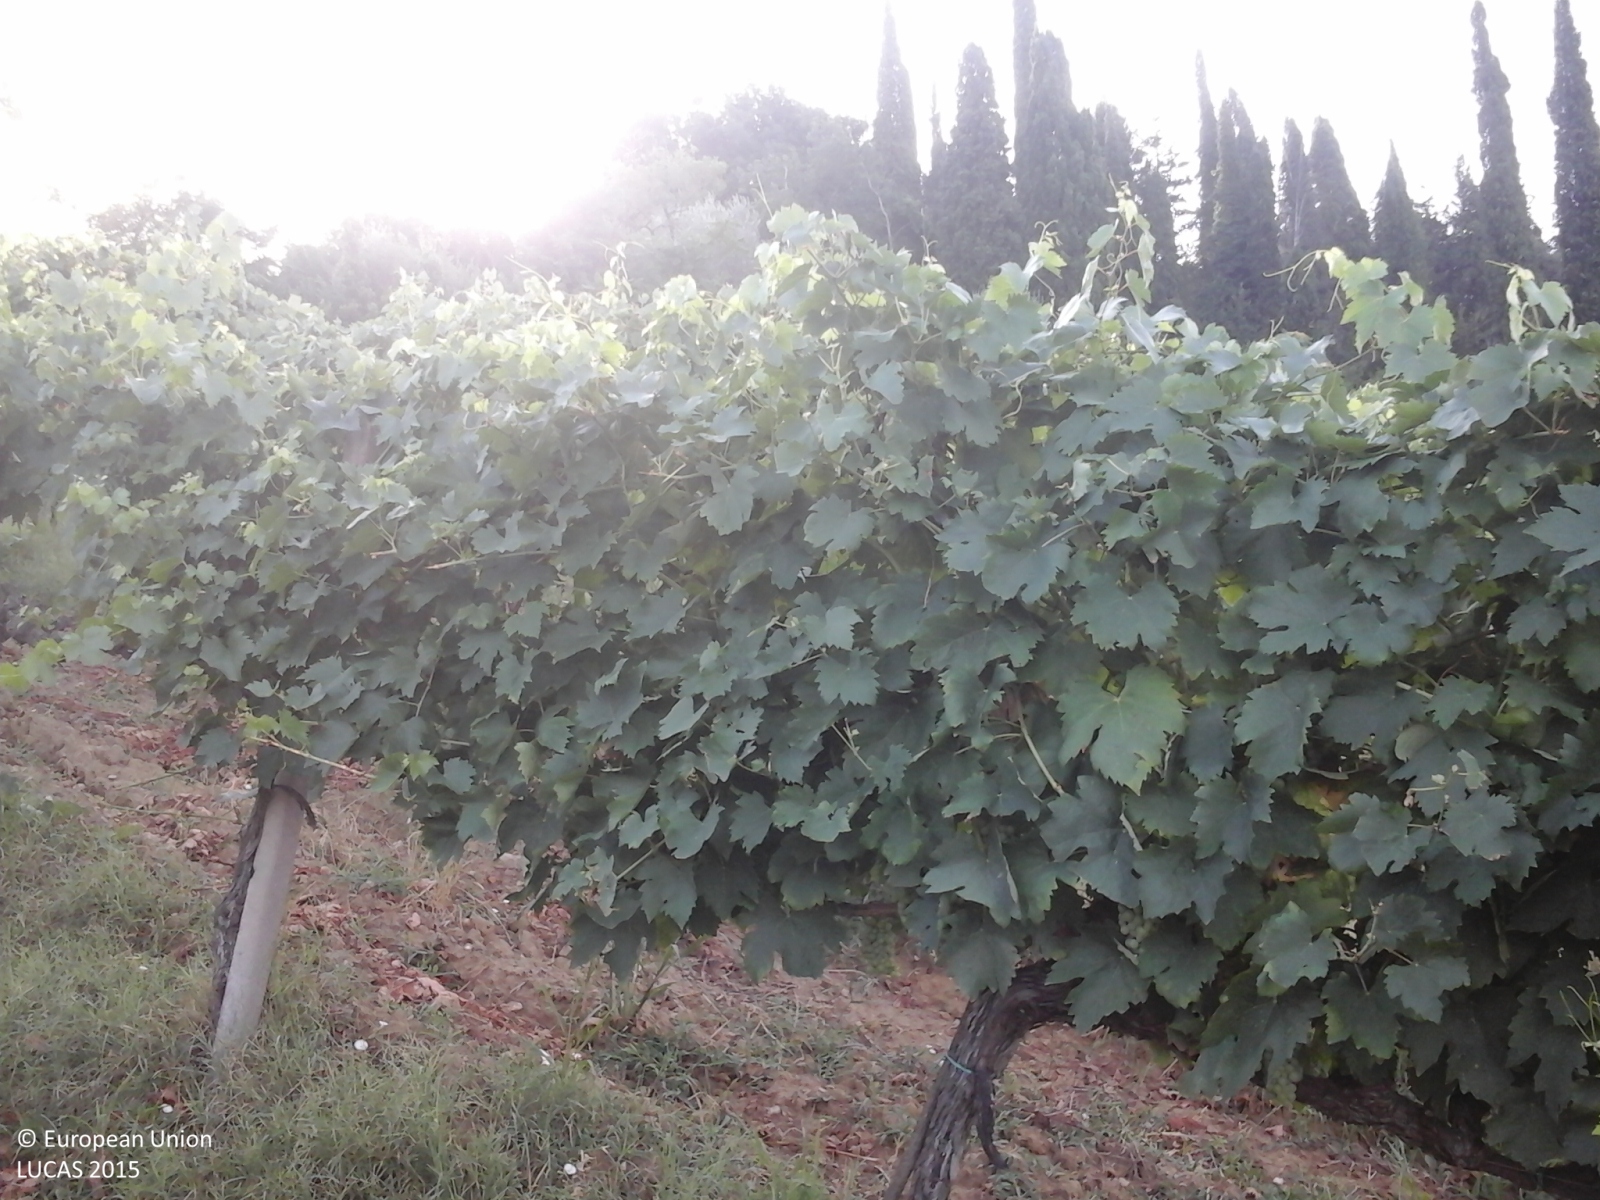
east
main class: Cropland
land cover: Vineyards
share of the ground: > 75 %
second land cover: Grassland without tree/shrub cover
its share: > 75 %
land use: Agriculture (excluding fallow land and kitchen gardens)
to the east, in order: Vineyards; Grassland without tree/shrub cover; Vineyards; Grassland with sparse tree/shrub cover; Tracks; Other mixed woodland; Artificial constructions in urban areas; Olive groves; Grassland without tree/shrub cover; Electric lines; Grassland with sparse tree/shrub cover; Paved roads, cycling and walking lanes; Grass margins; Olive groves; Grassland without tree/shrub cover; Lines of trees
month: July
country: IT
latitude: 43.4609
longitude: 11.0723
